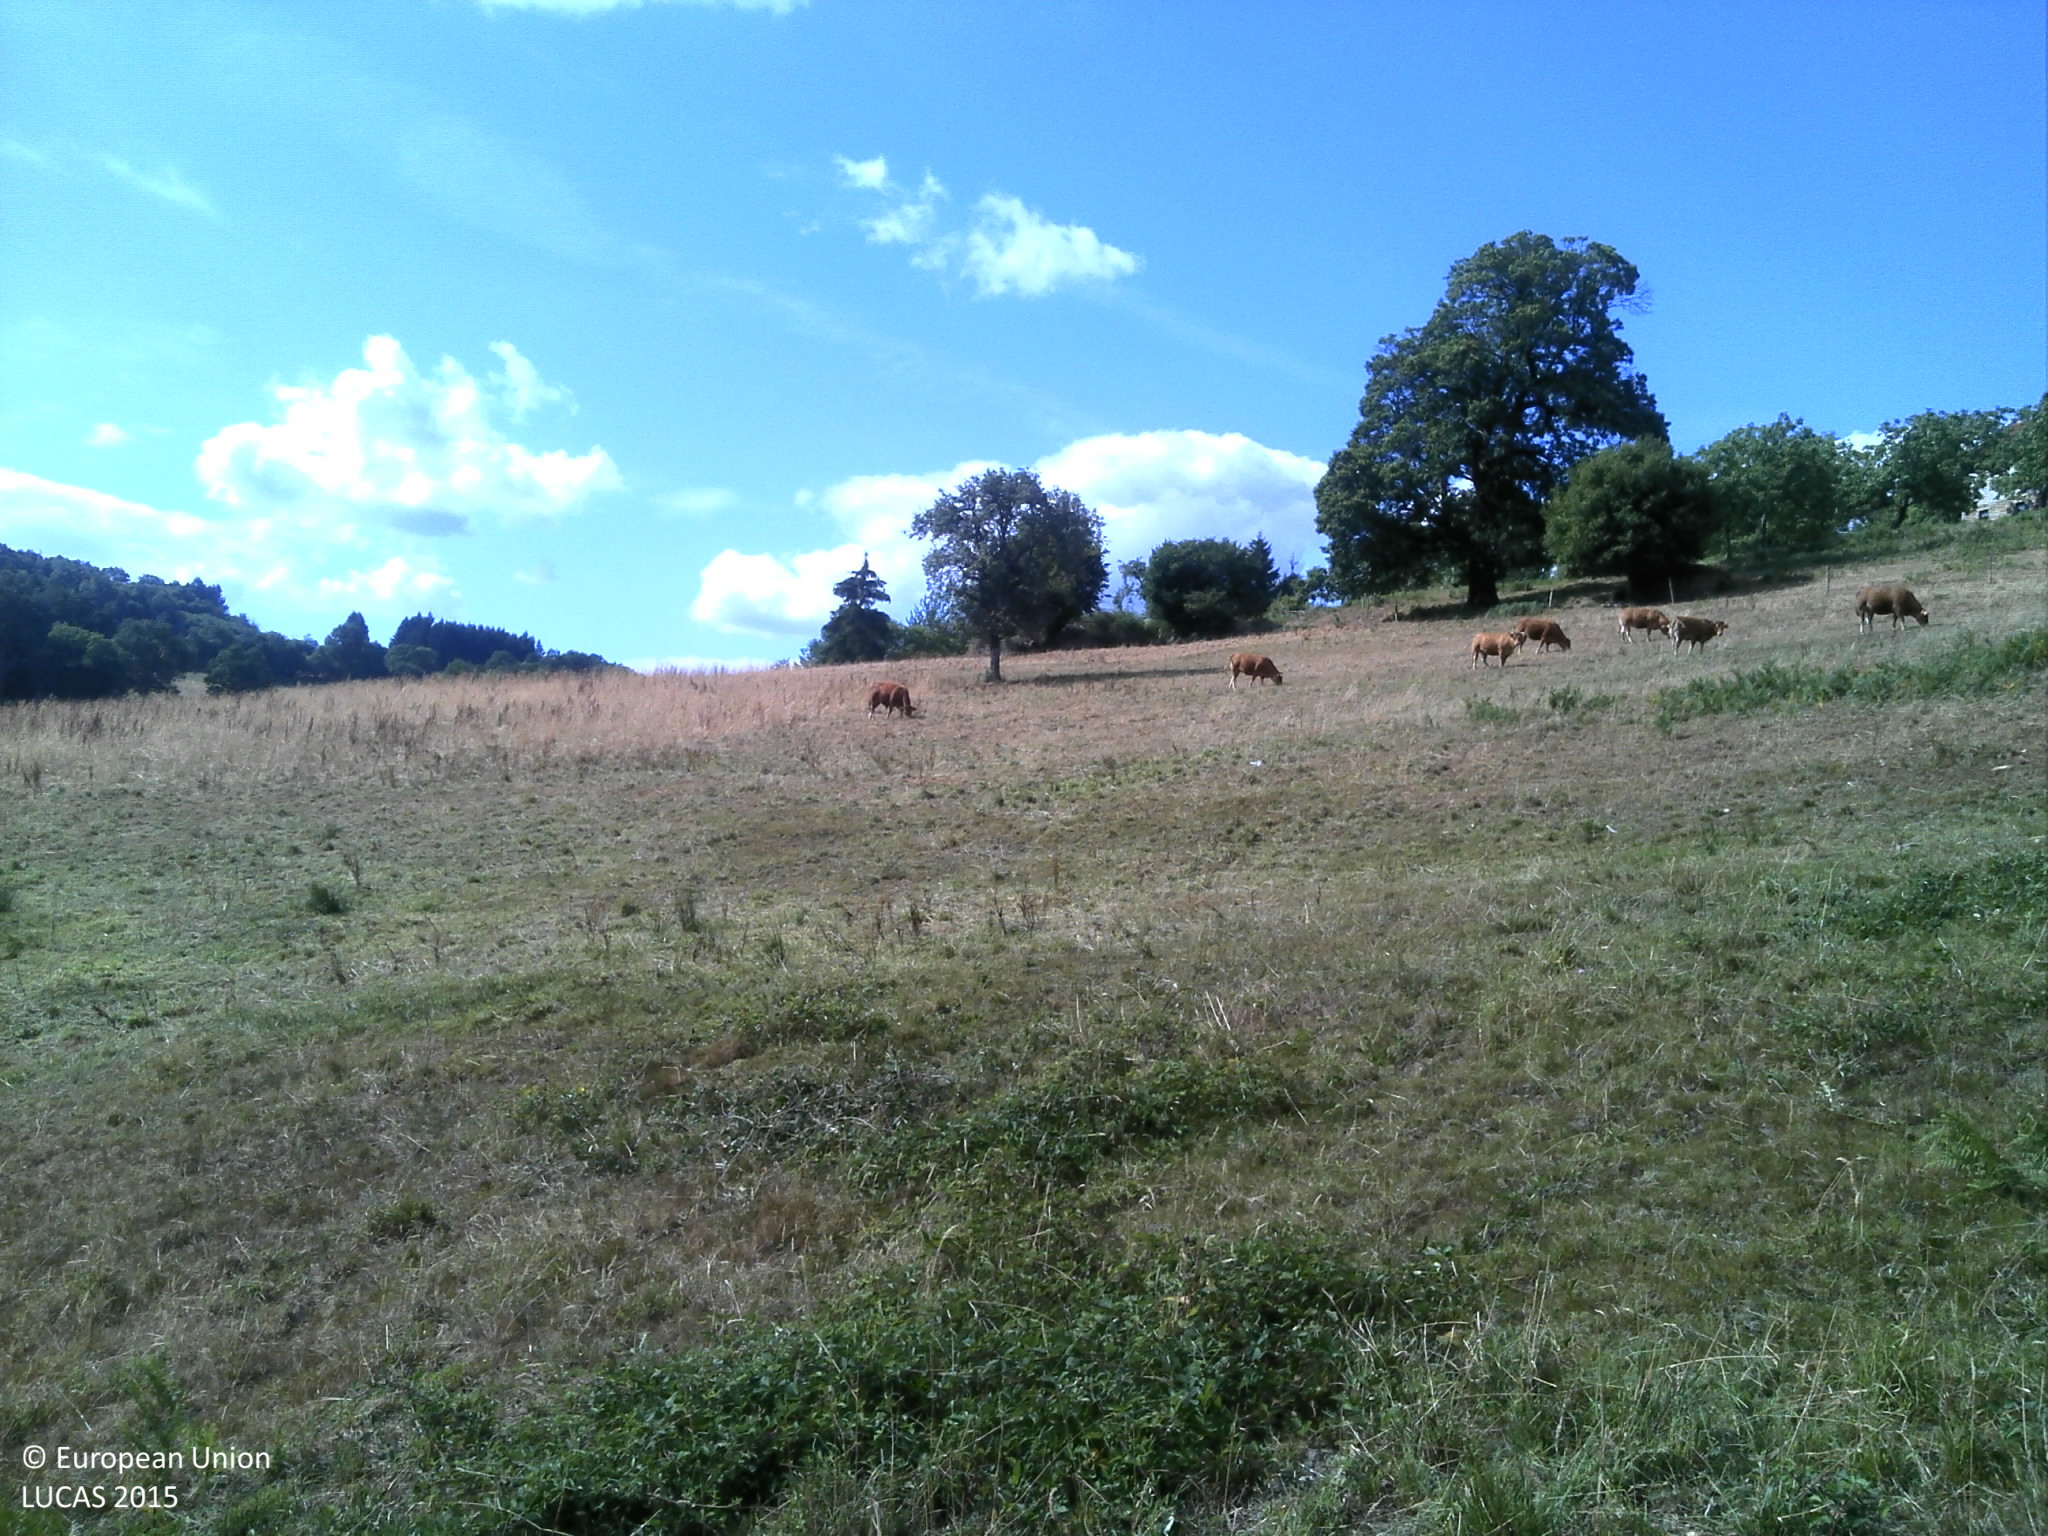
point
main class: Grassland
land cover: Grassland without tree/shrub cover
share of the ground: > 75 %
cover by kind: herbaceous plants 100 %
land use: Agriculture (excluding fallow land and kitchen gardens)
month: July
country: FR
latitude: 45.1423
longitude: 1.7173
